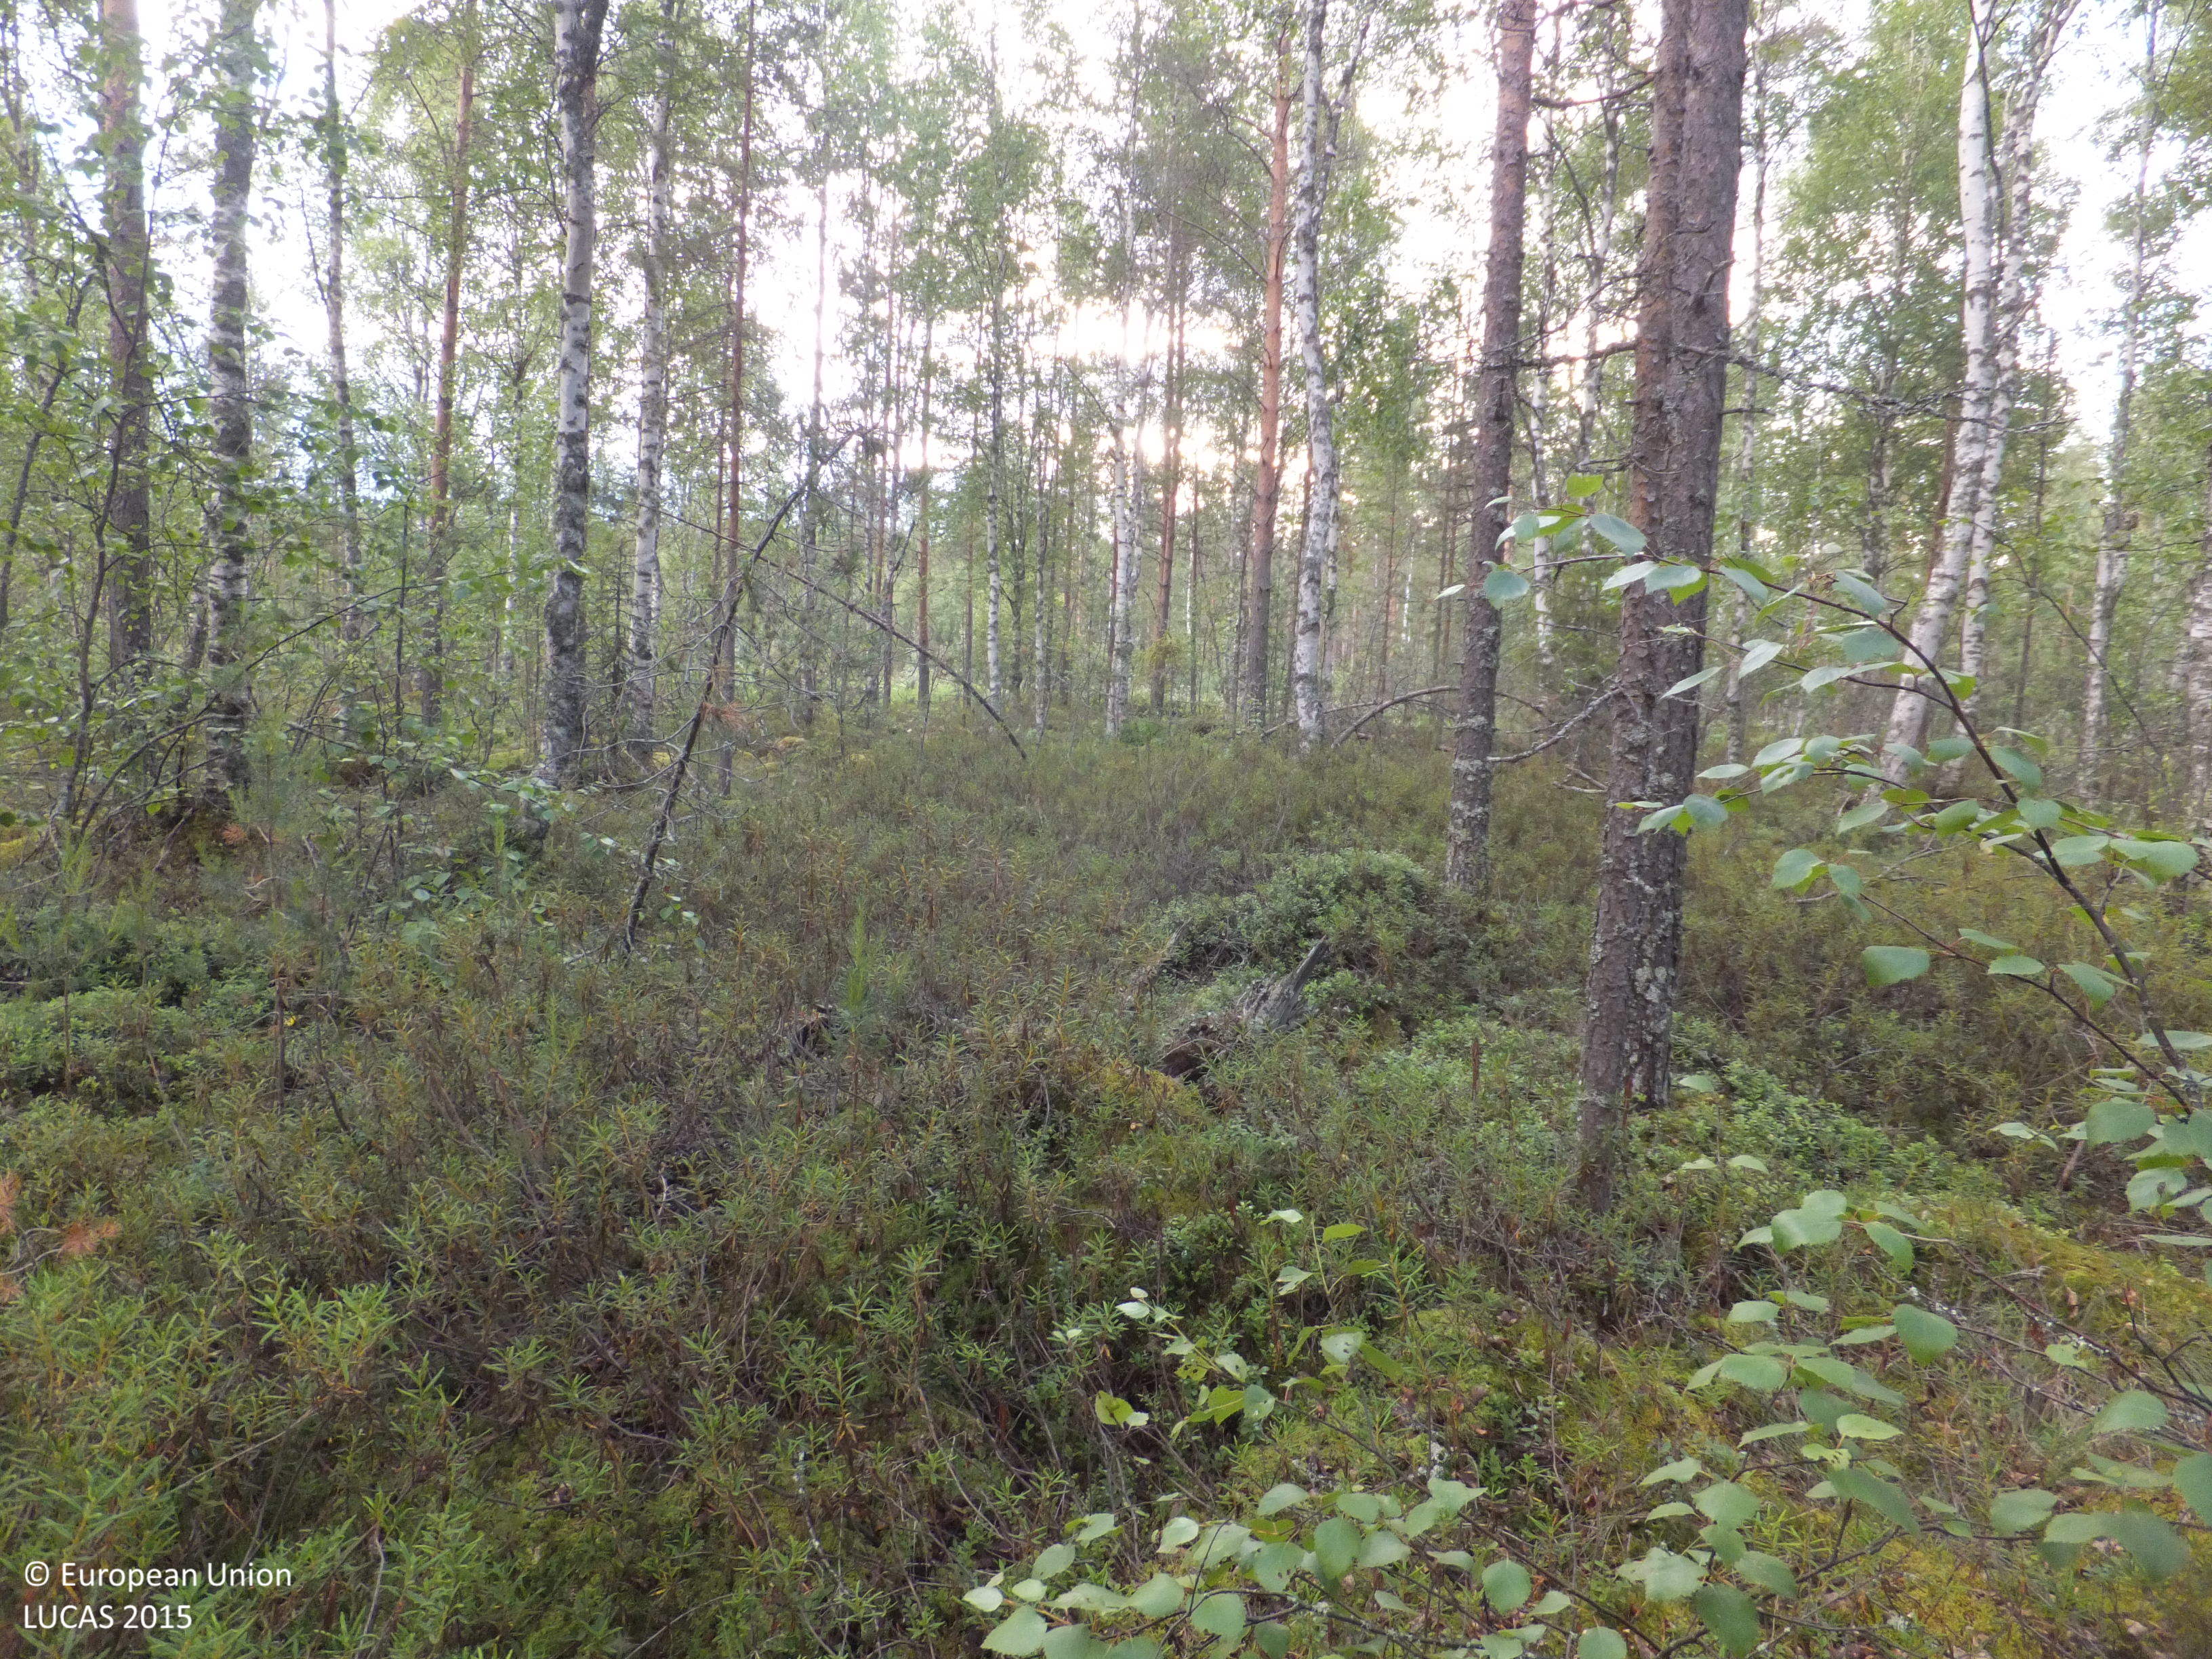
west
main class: Woodland
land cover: Pine dominated mixed woodland
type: boreal forest
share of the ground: > 75 %
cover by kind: broadleaved forest trees 60 %, coniferous forest trees 20 %, shrubs 10 %, lichens and mosses 10 %
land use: Forestry
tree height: > 5 m
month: July
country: FI
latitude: 63.0108
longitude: 24.4829
